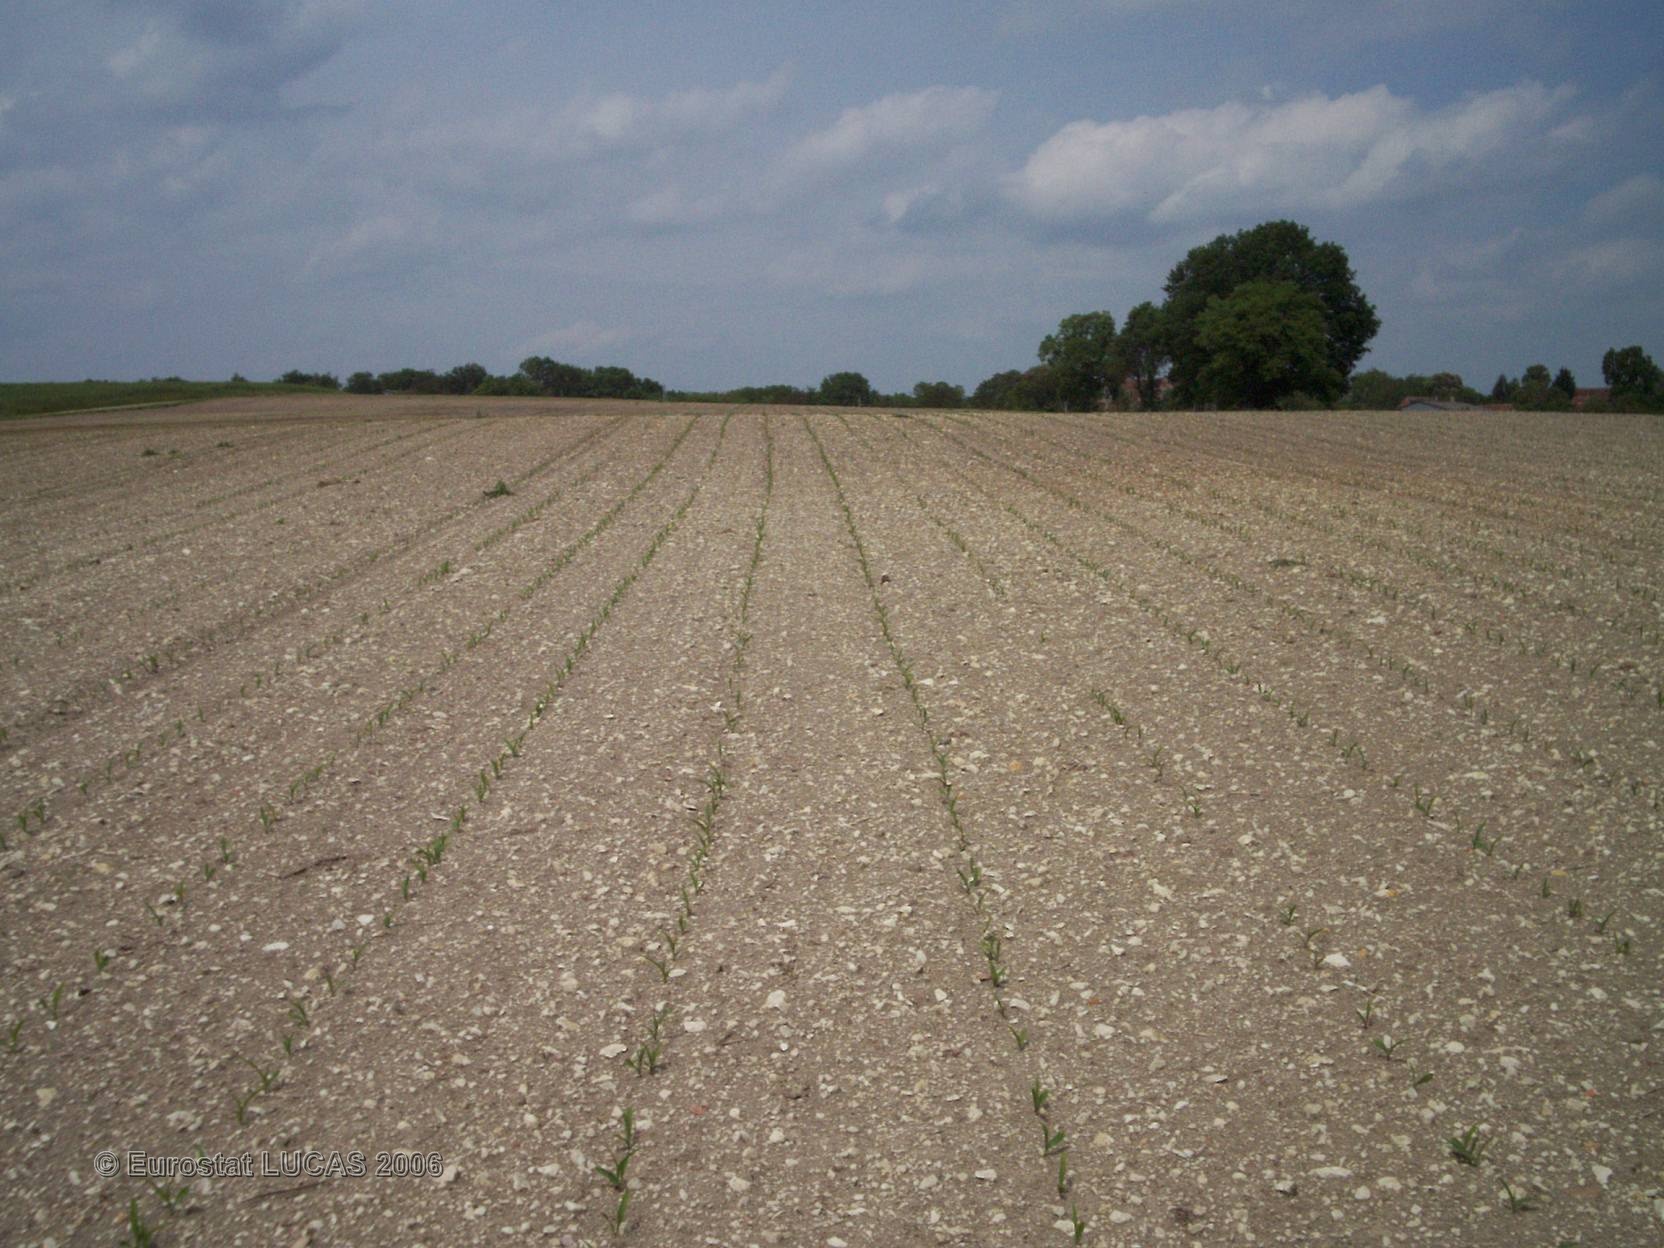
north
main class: Cropland
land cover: Maize
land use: Agriculture (excluding fallow land and kitchen gardens)
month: May
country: FR
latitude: 46.7852
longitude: 0.9862
